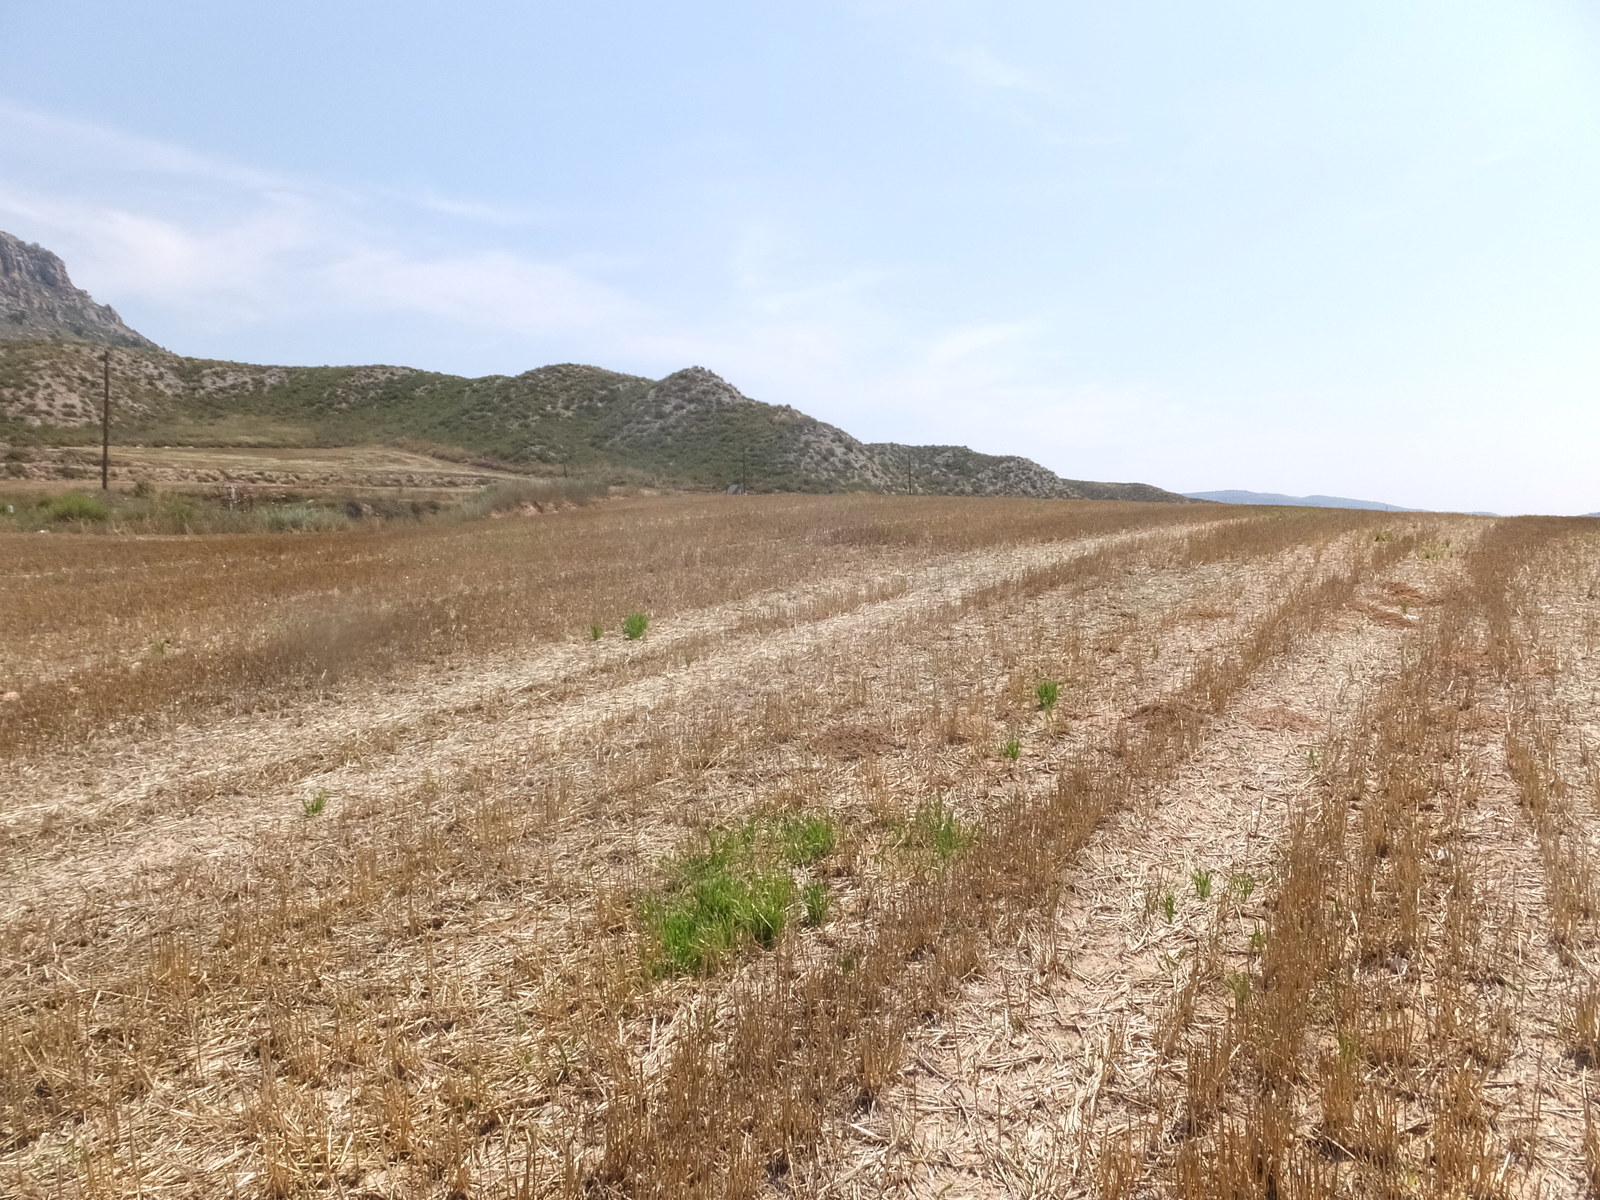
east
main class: Cropland
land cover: Barley
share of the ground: < 10 %
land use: Agriculture (excluding fallow land and kitchen gardens)
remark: Harvested field
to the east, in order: Barley; Grass margins; Ditches and canals; Grass margins; Paved roads, cycling and walking lanes; Grass margins; Ditches and canals; Grass margins; Other bare soil; Shrubland without tree cover; Barley; Tracks; Electric lines; Shrubland without tree cover
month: June
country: ES
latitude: 41.8662
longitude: 0.5521
